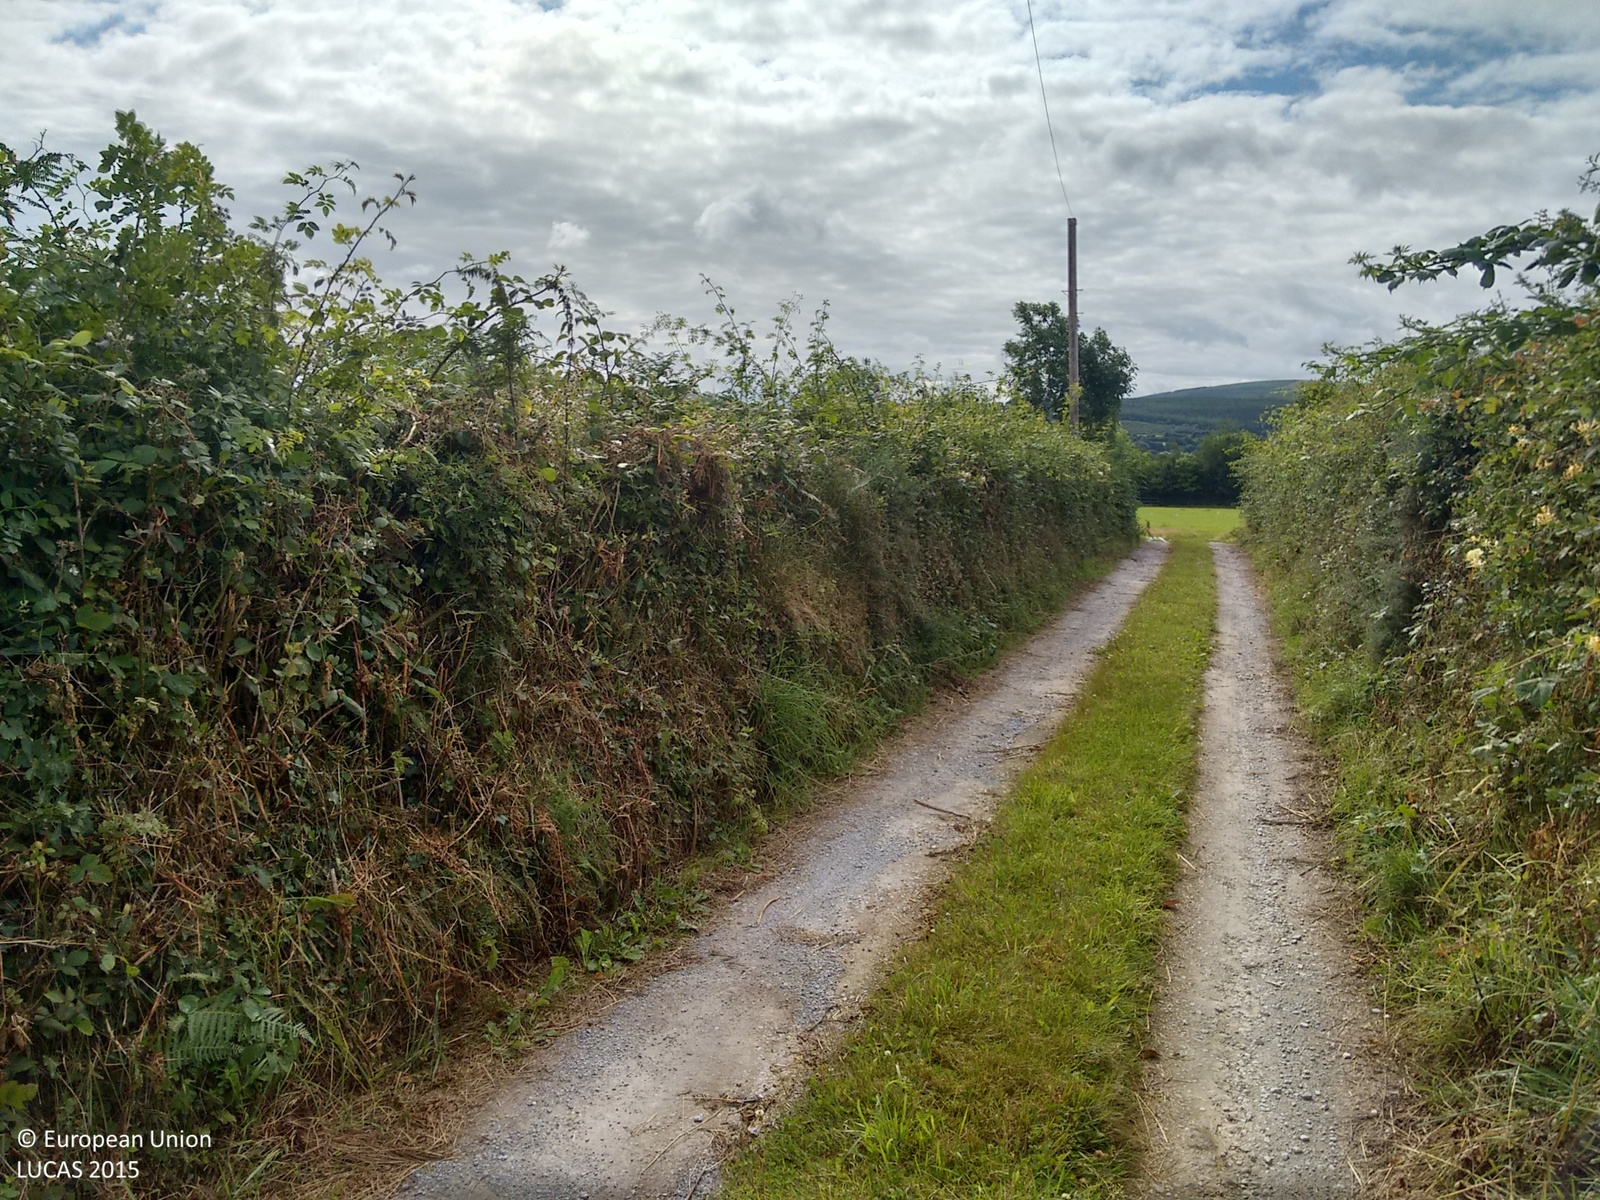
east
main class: Cropland
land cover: Oats
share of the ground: > 75 %
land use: Agriculture (excluding fallow land and kitchen gardens)
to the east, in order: Oats; Broadleaved woodland; Ditches and canals; Broadleaved woodland; Grassland without tree/shrub cover; Fences; Paved roads, cycling and walking lanes; Grassland without tree/shrub cover
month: July
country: IE
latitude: 52.1247
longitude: -8.9513
